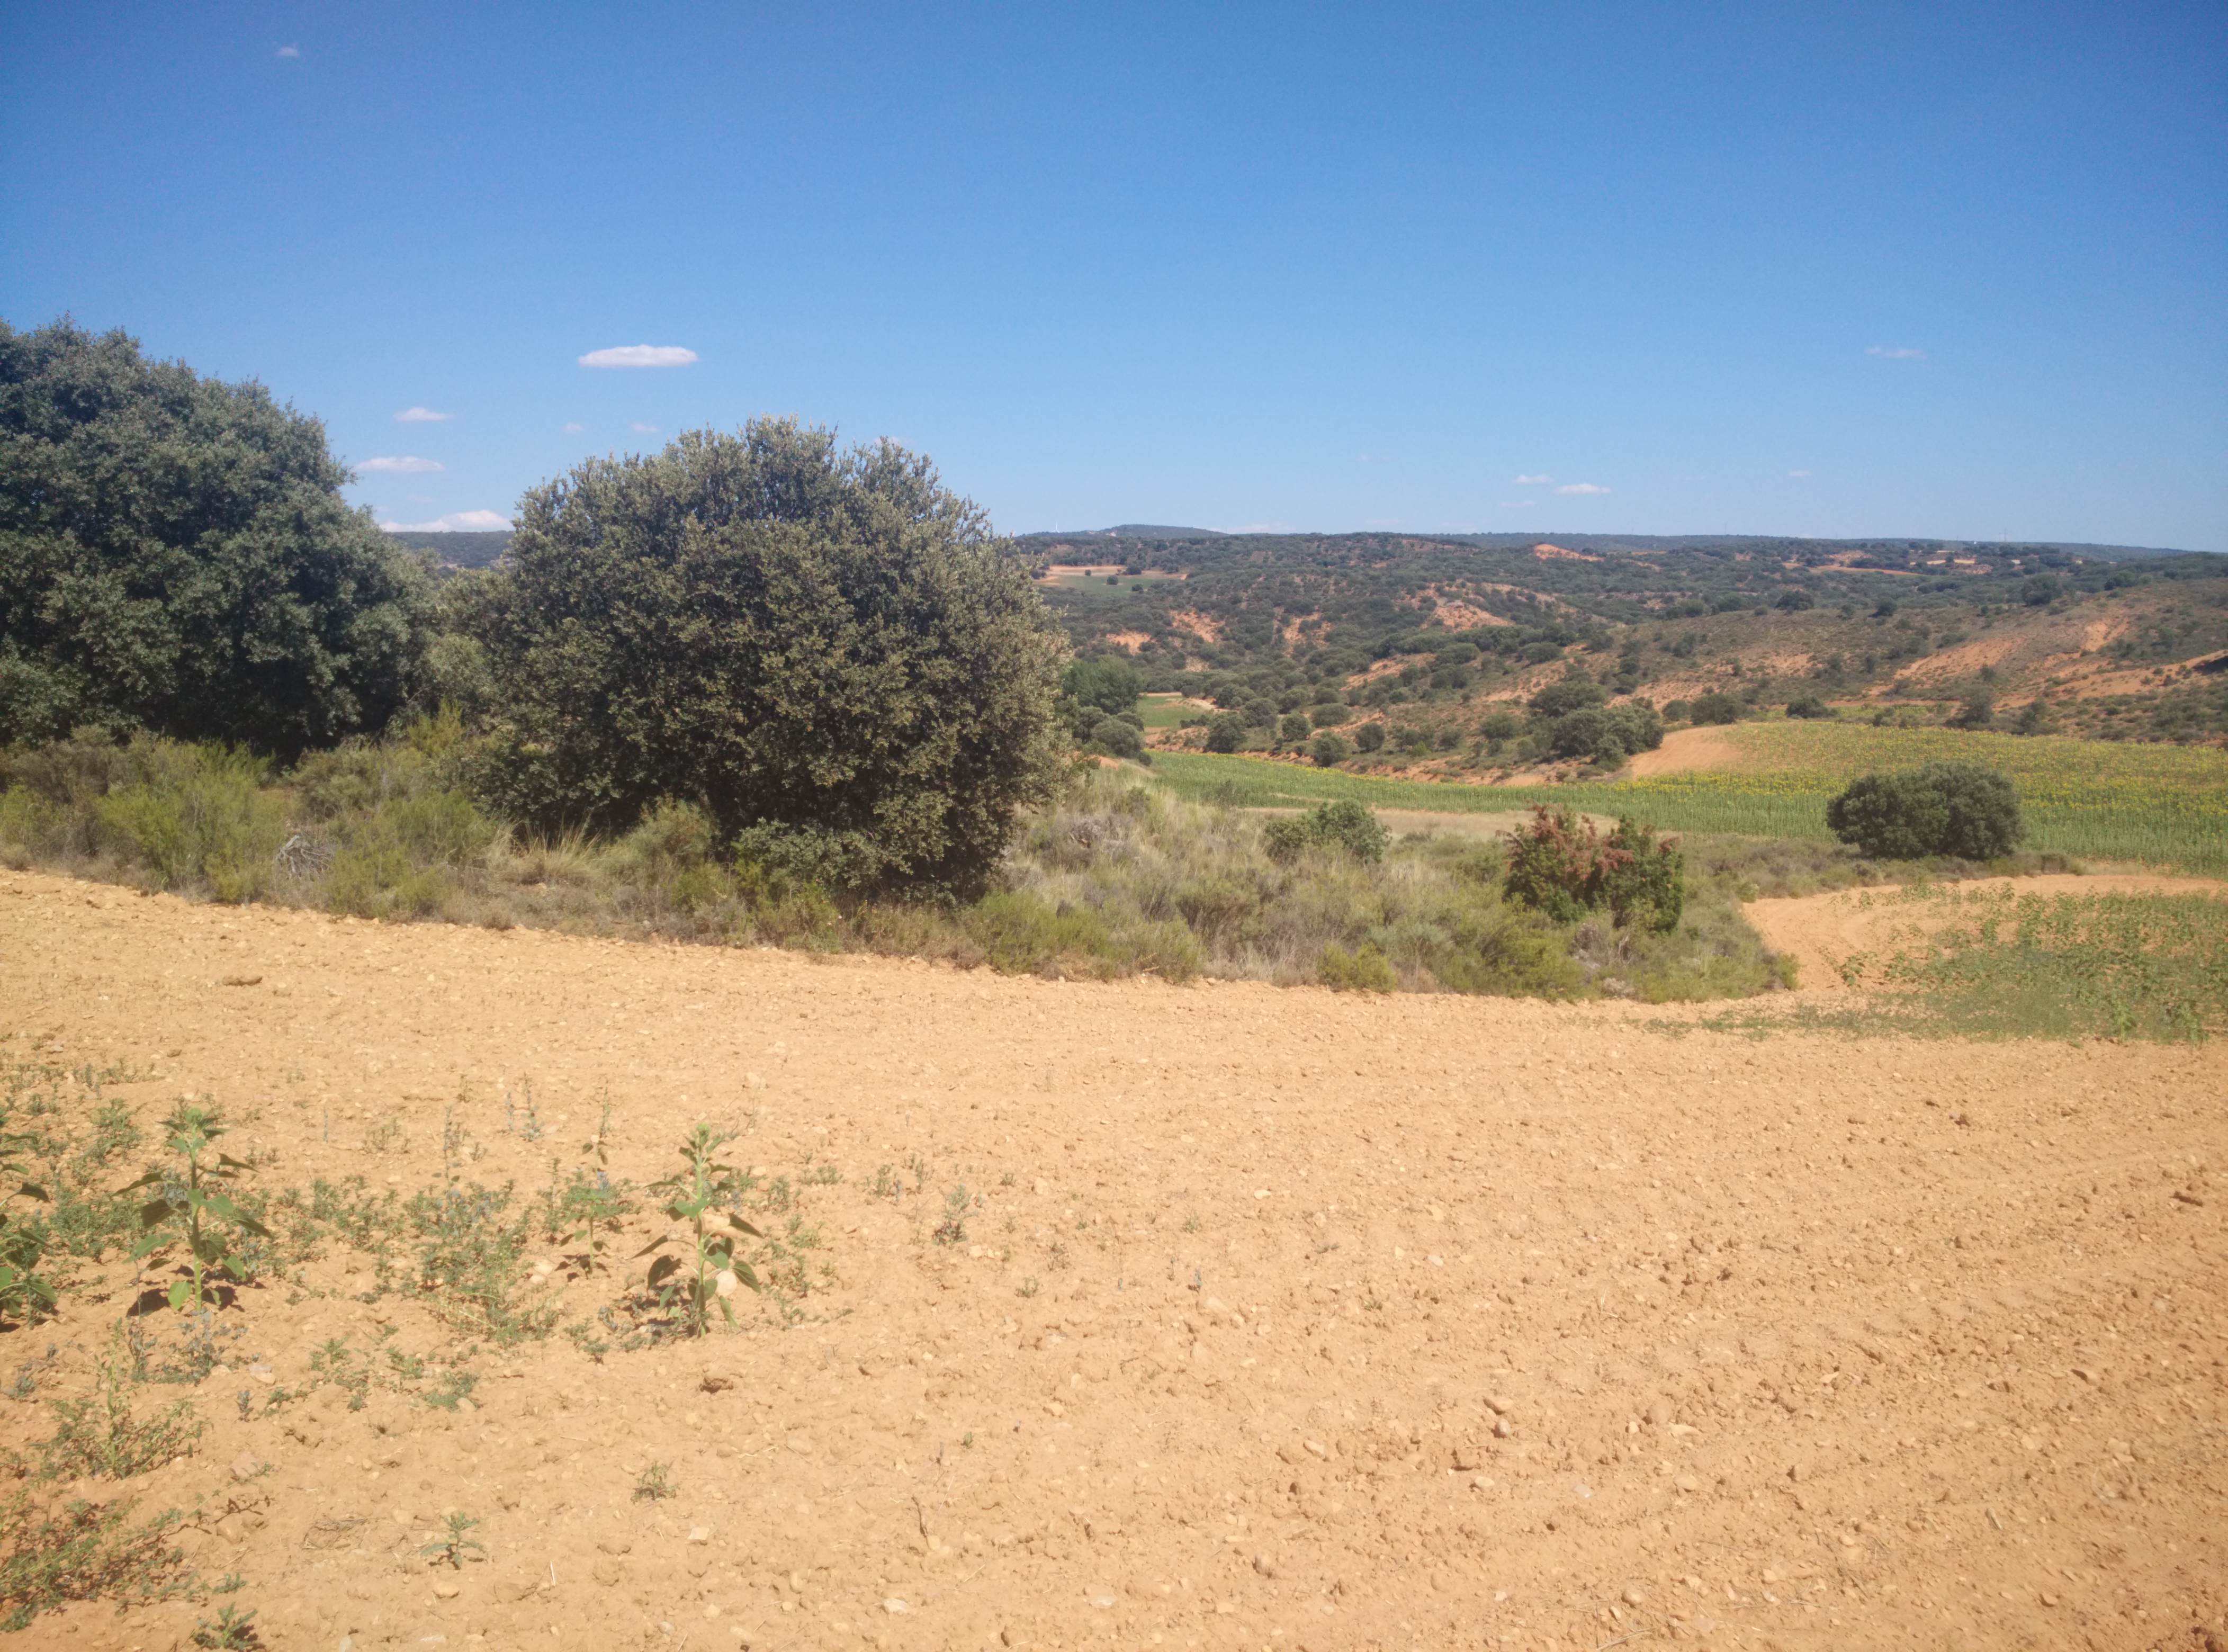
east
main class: Shrubland
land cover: Shrubland with sparse tree cover
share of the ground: > 75 %
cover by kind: shrubs 85 %, unconsolidated bare surface 10 %, broadleaved forest trees 5 %
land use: Semi-natural and natural areas not in use
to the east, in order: Shrubland with sparse tree cover; Sunflower; Shrubland with sparse tree cover; Shrubland without tree cover; Shrubland with sparse tree cover; Sunflower
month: July
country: ES
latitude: 40.8155
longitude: -2.6557
